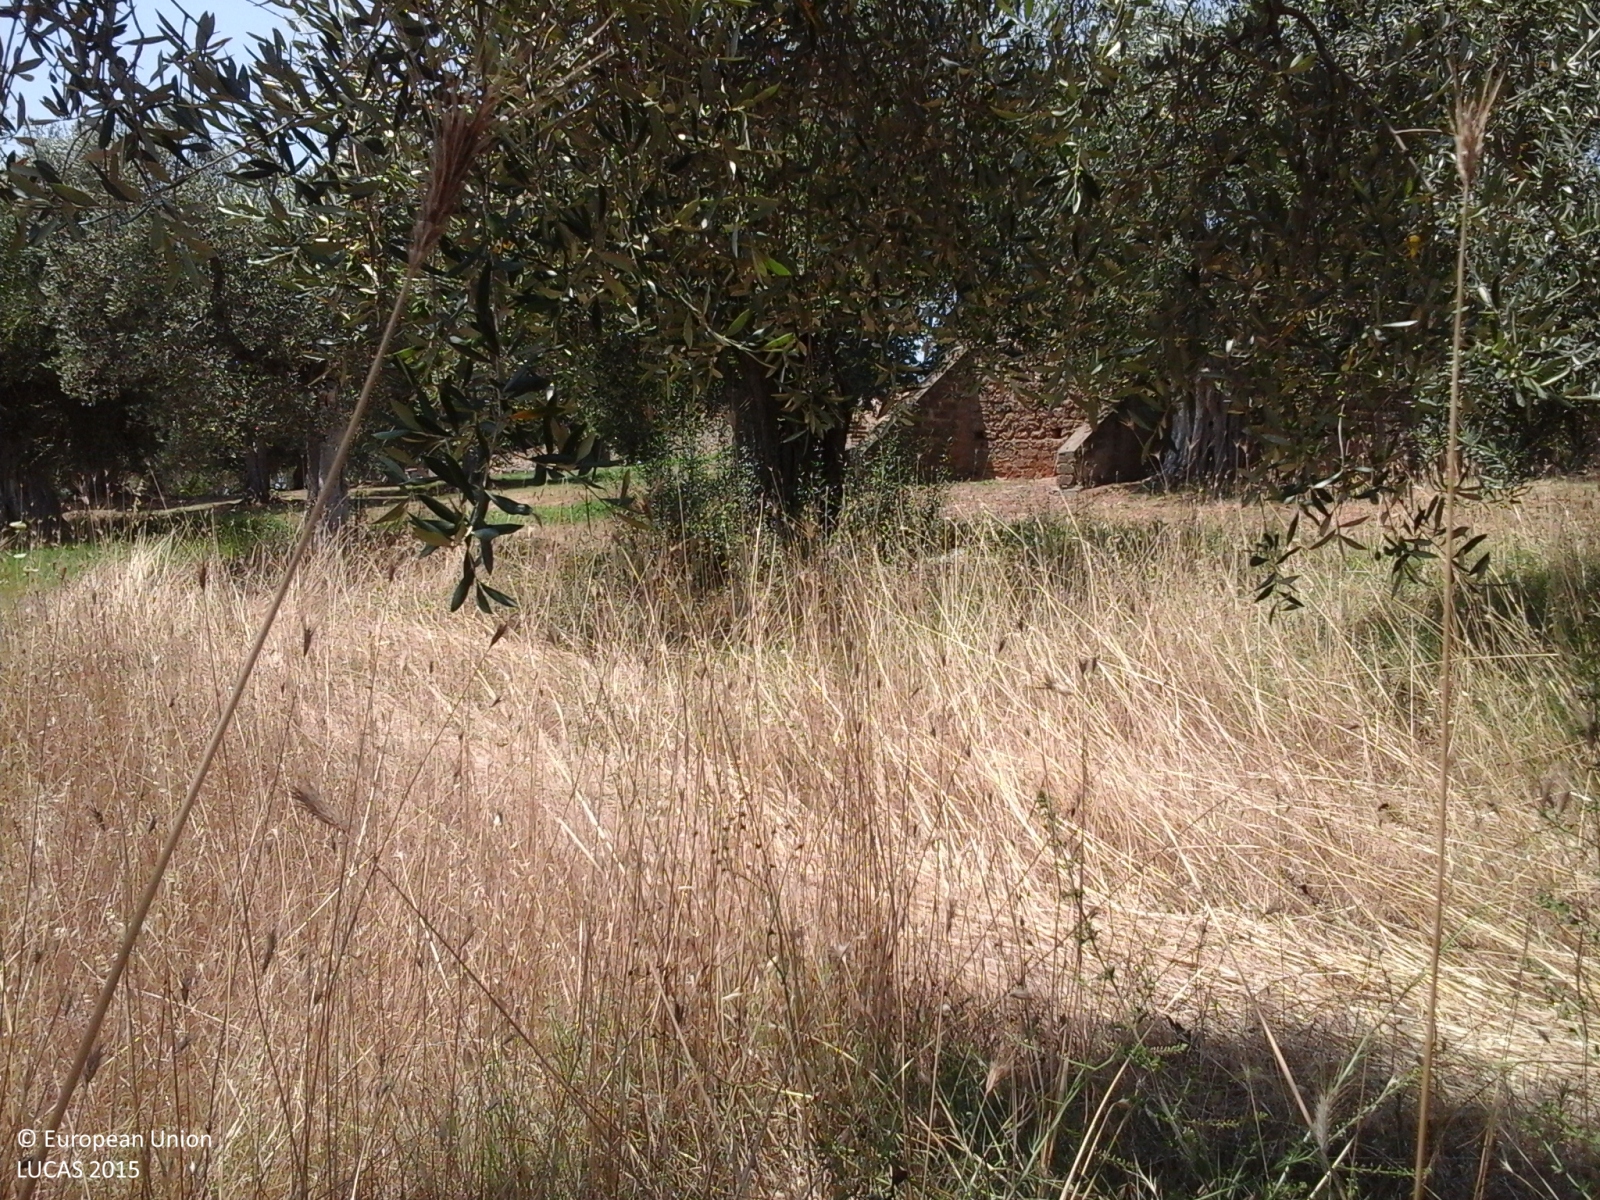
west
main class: Cropland
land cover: Olive groves
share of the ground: 50 - 75 %
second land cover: Grassland without tree/shrub cover
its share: 50 - 75 %
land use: Agriculture (excluding fallow land and kitchen gardens)
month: July
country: IT
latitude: 42.4266
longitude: 11.4656
